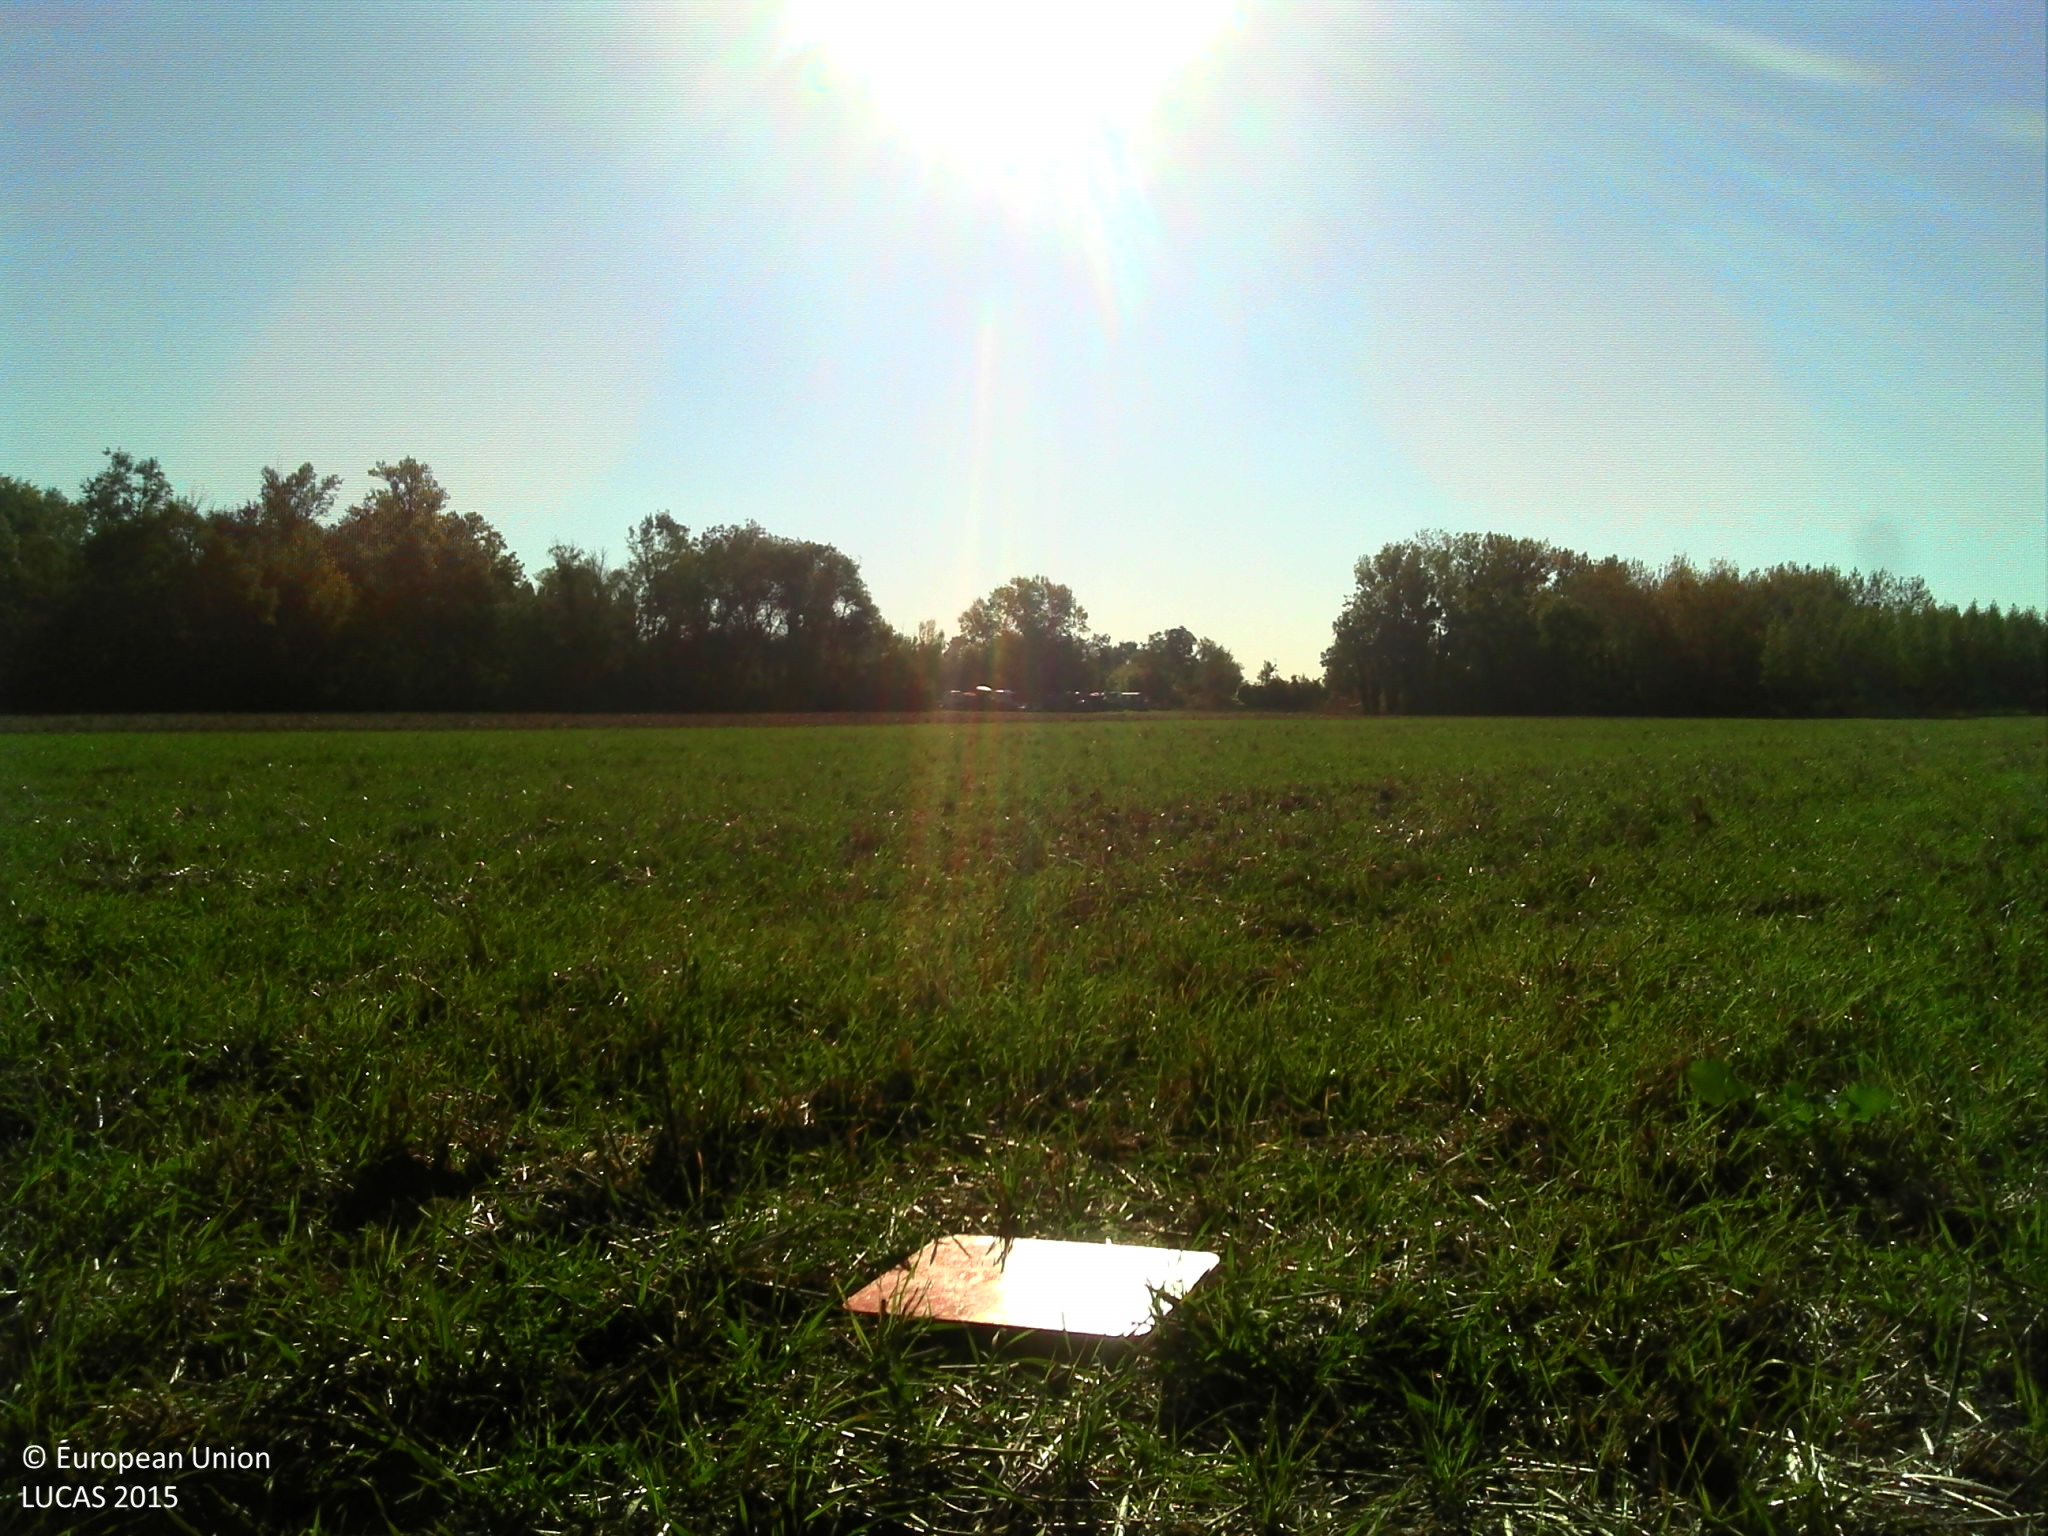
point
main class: Cropland
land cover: Common wheat
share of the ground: < 10 %
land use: Agriculture (excluding fallow land and kitchen gardens)
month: September
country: FR
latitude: 48.4579
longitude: 3.3811
